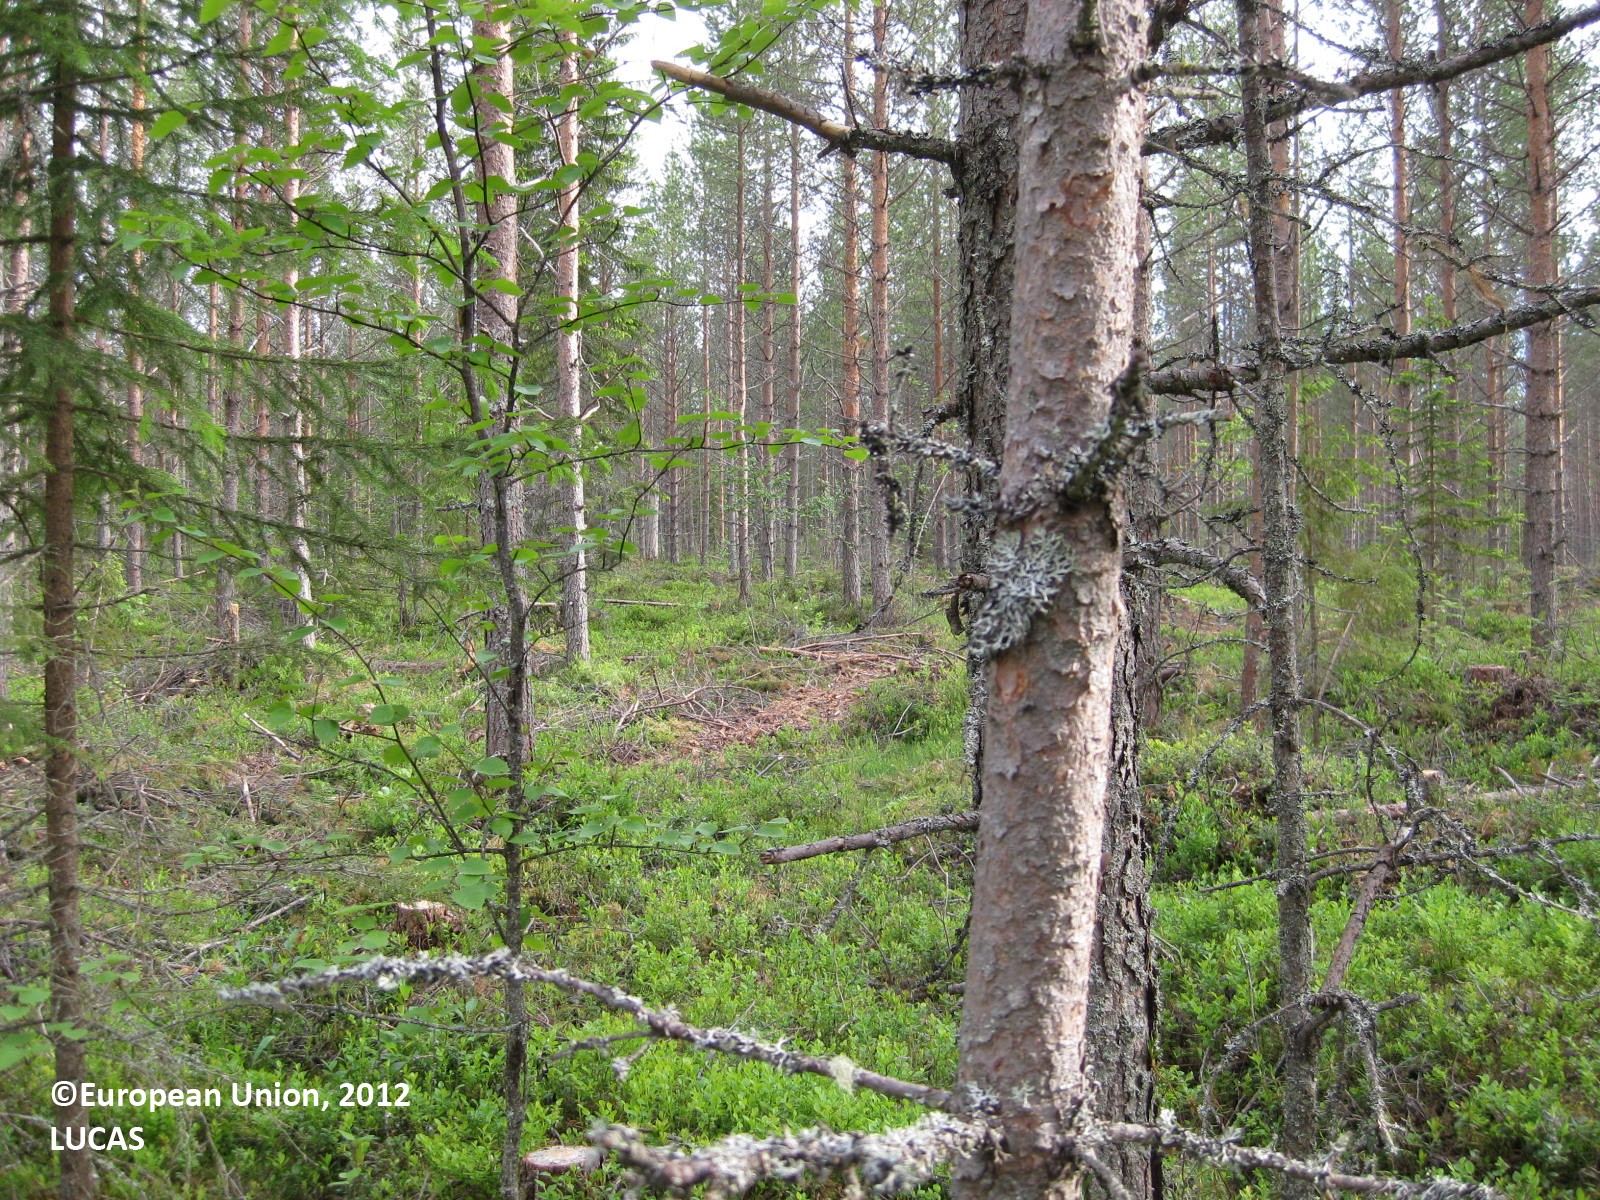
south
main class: Woodland
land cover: Pine dominated coniferous woodland
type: boreal forest
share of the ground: > 75 %
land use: Forestry
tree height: > 5 m
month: June
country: FI
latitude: 65.2750
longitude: 28.1741
